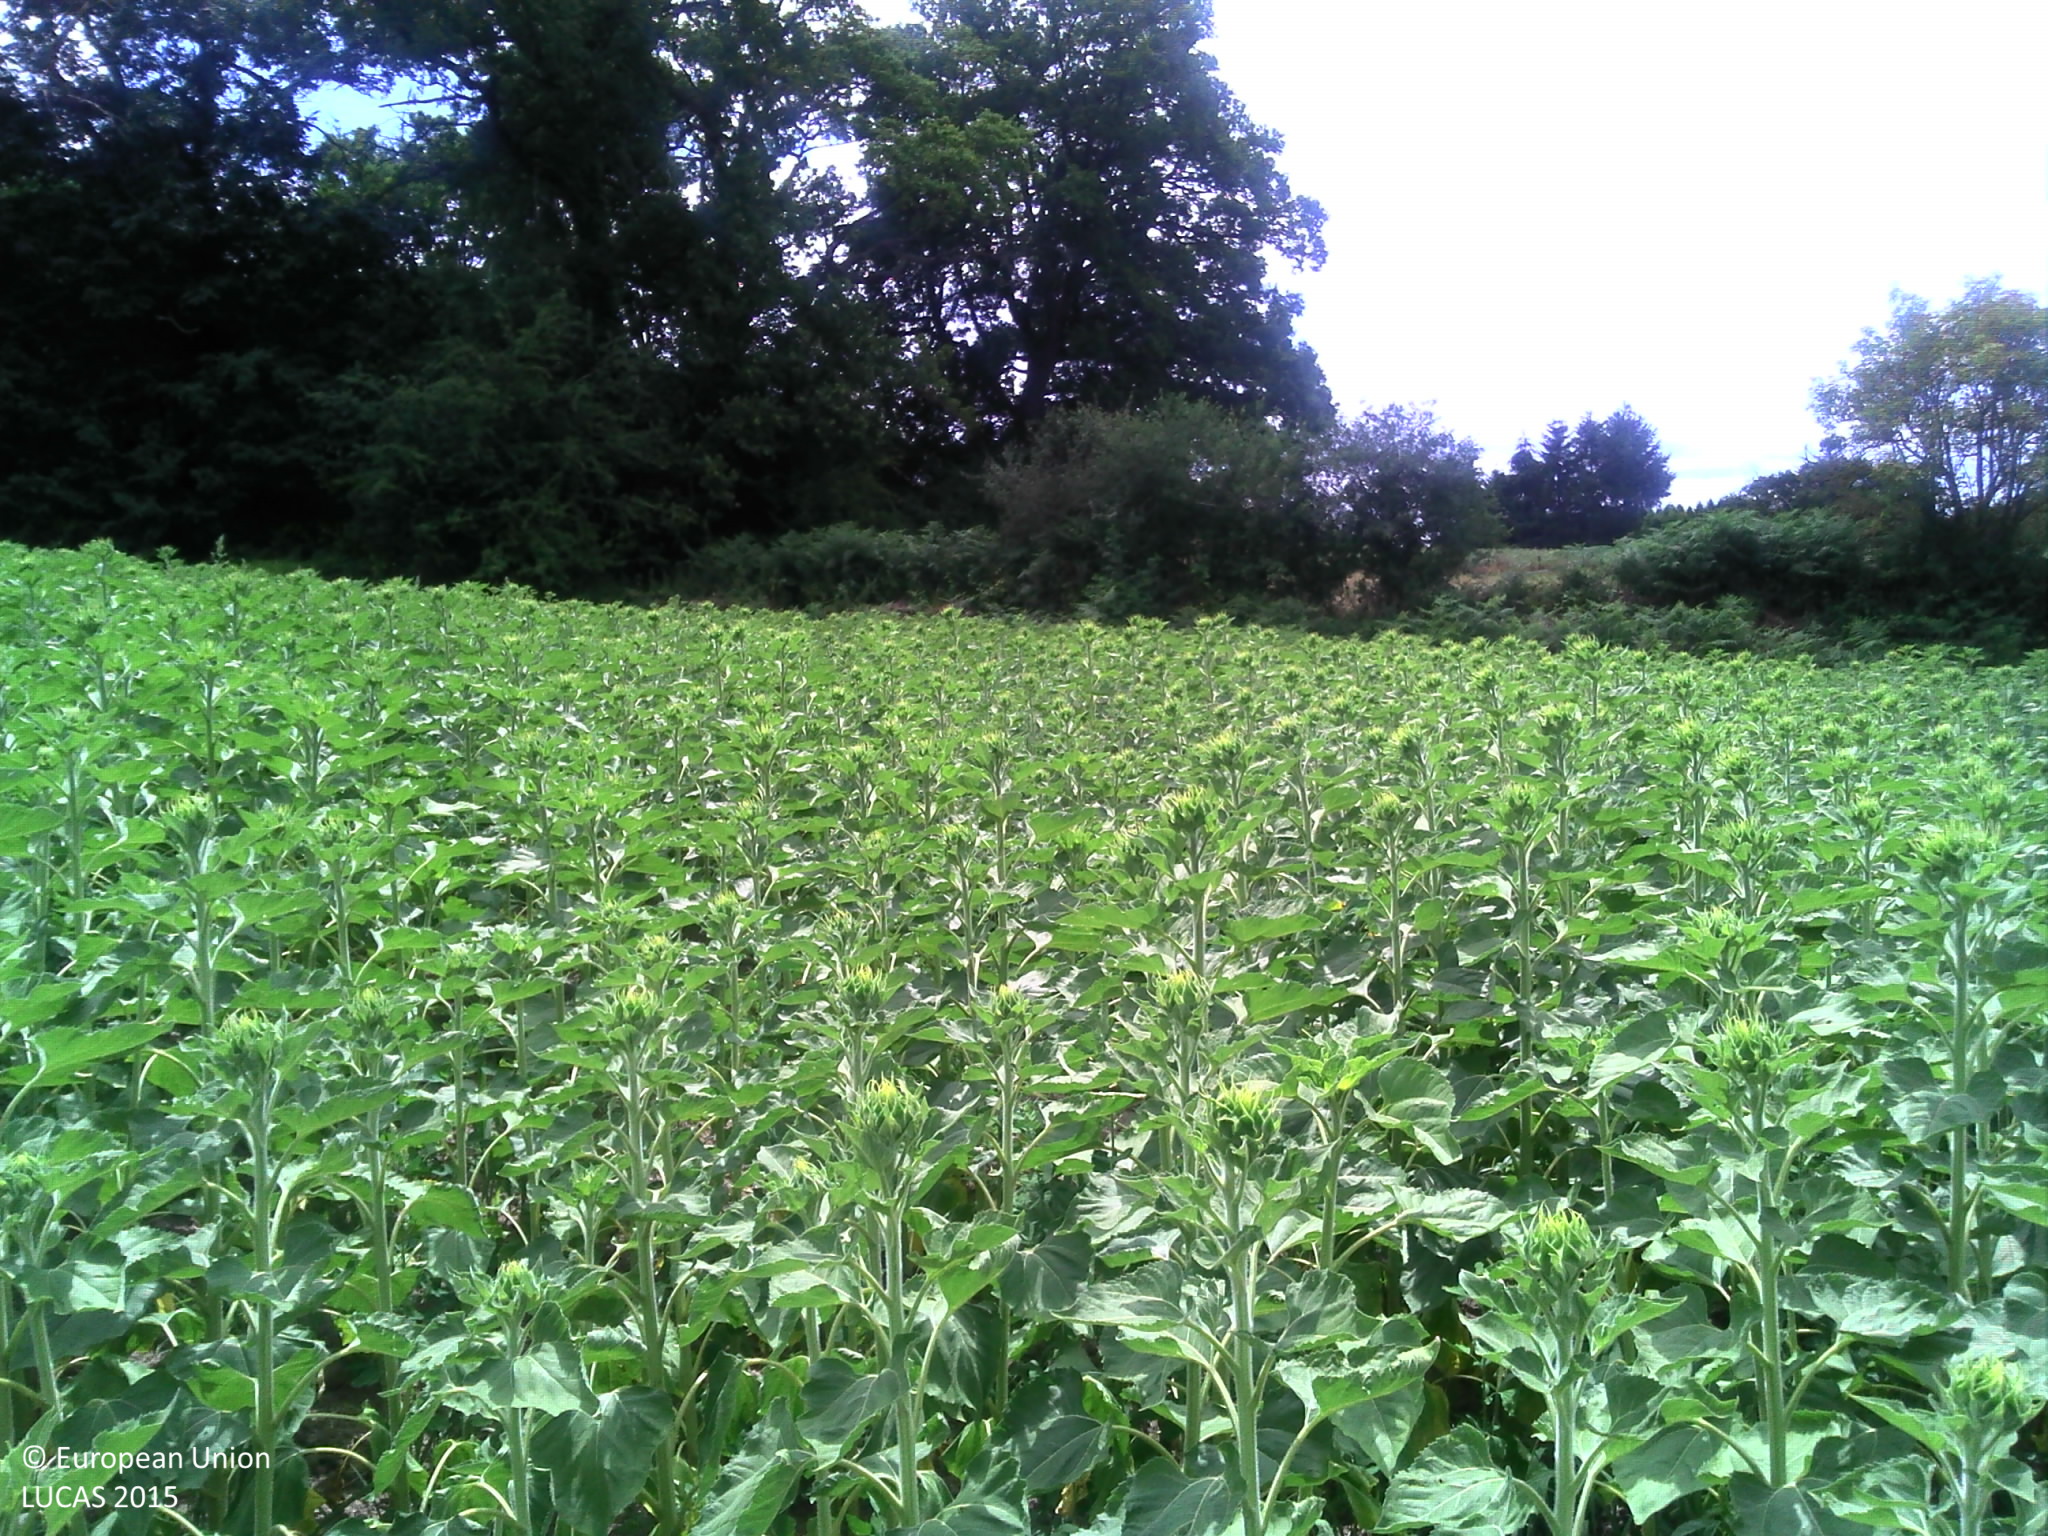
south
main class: Cropland
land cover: Sunflower
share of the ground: > 75 %
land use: Agriculture (excluding fallow land and kitchen gardens)
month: July
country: FR
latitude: 46.3649
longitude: 1.6071
